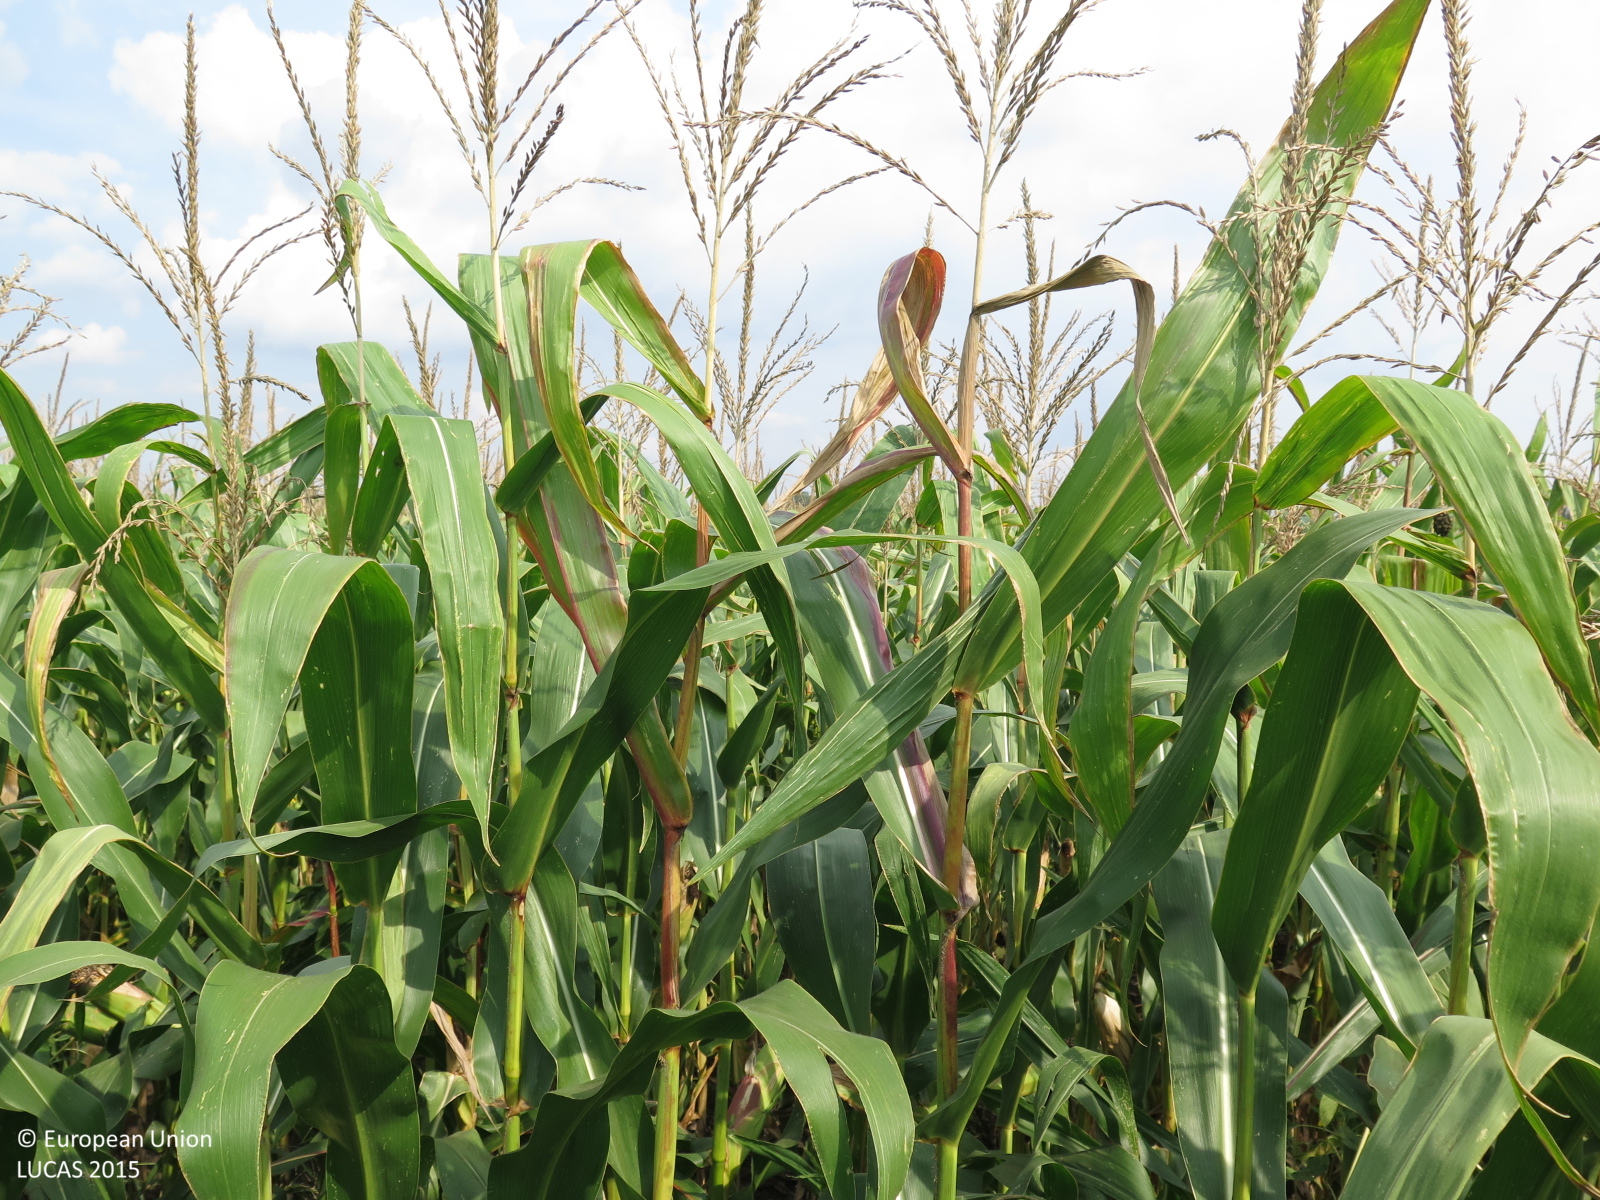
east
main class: Cropland
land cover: Maize
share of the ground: > 75 %
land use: Agriculture (excluding fallow land and kitchen gardens)
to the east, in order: Maize
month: August
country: CZ
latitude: 48.7994
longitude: 16.9379
